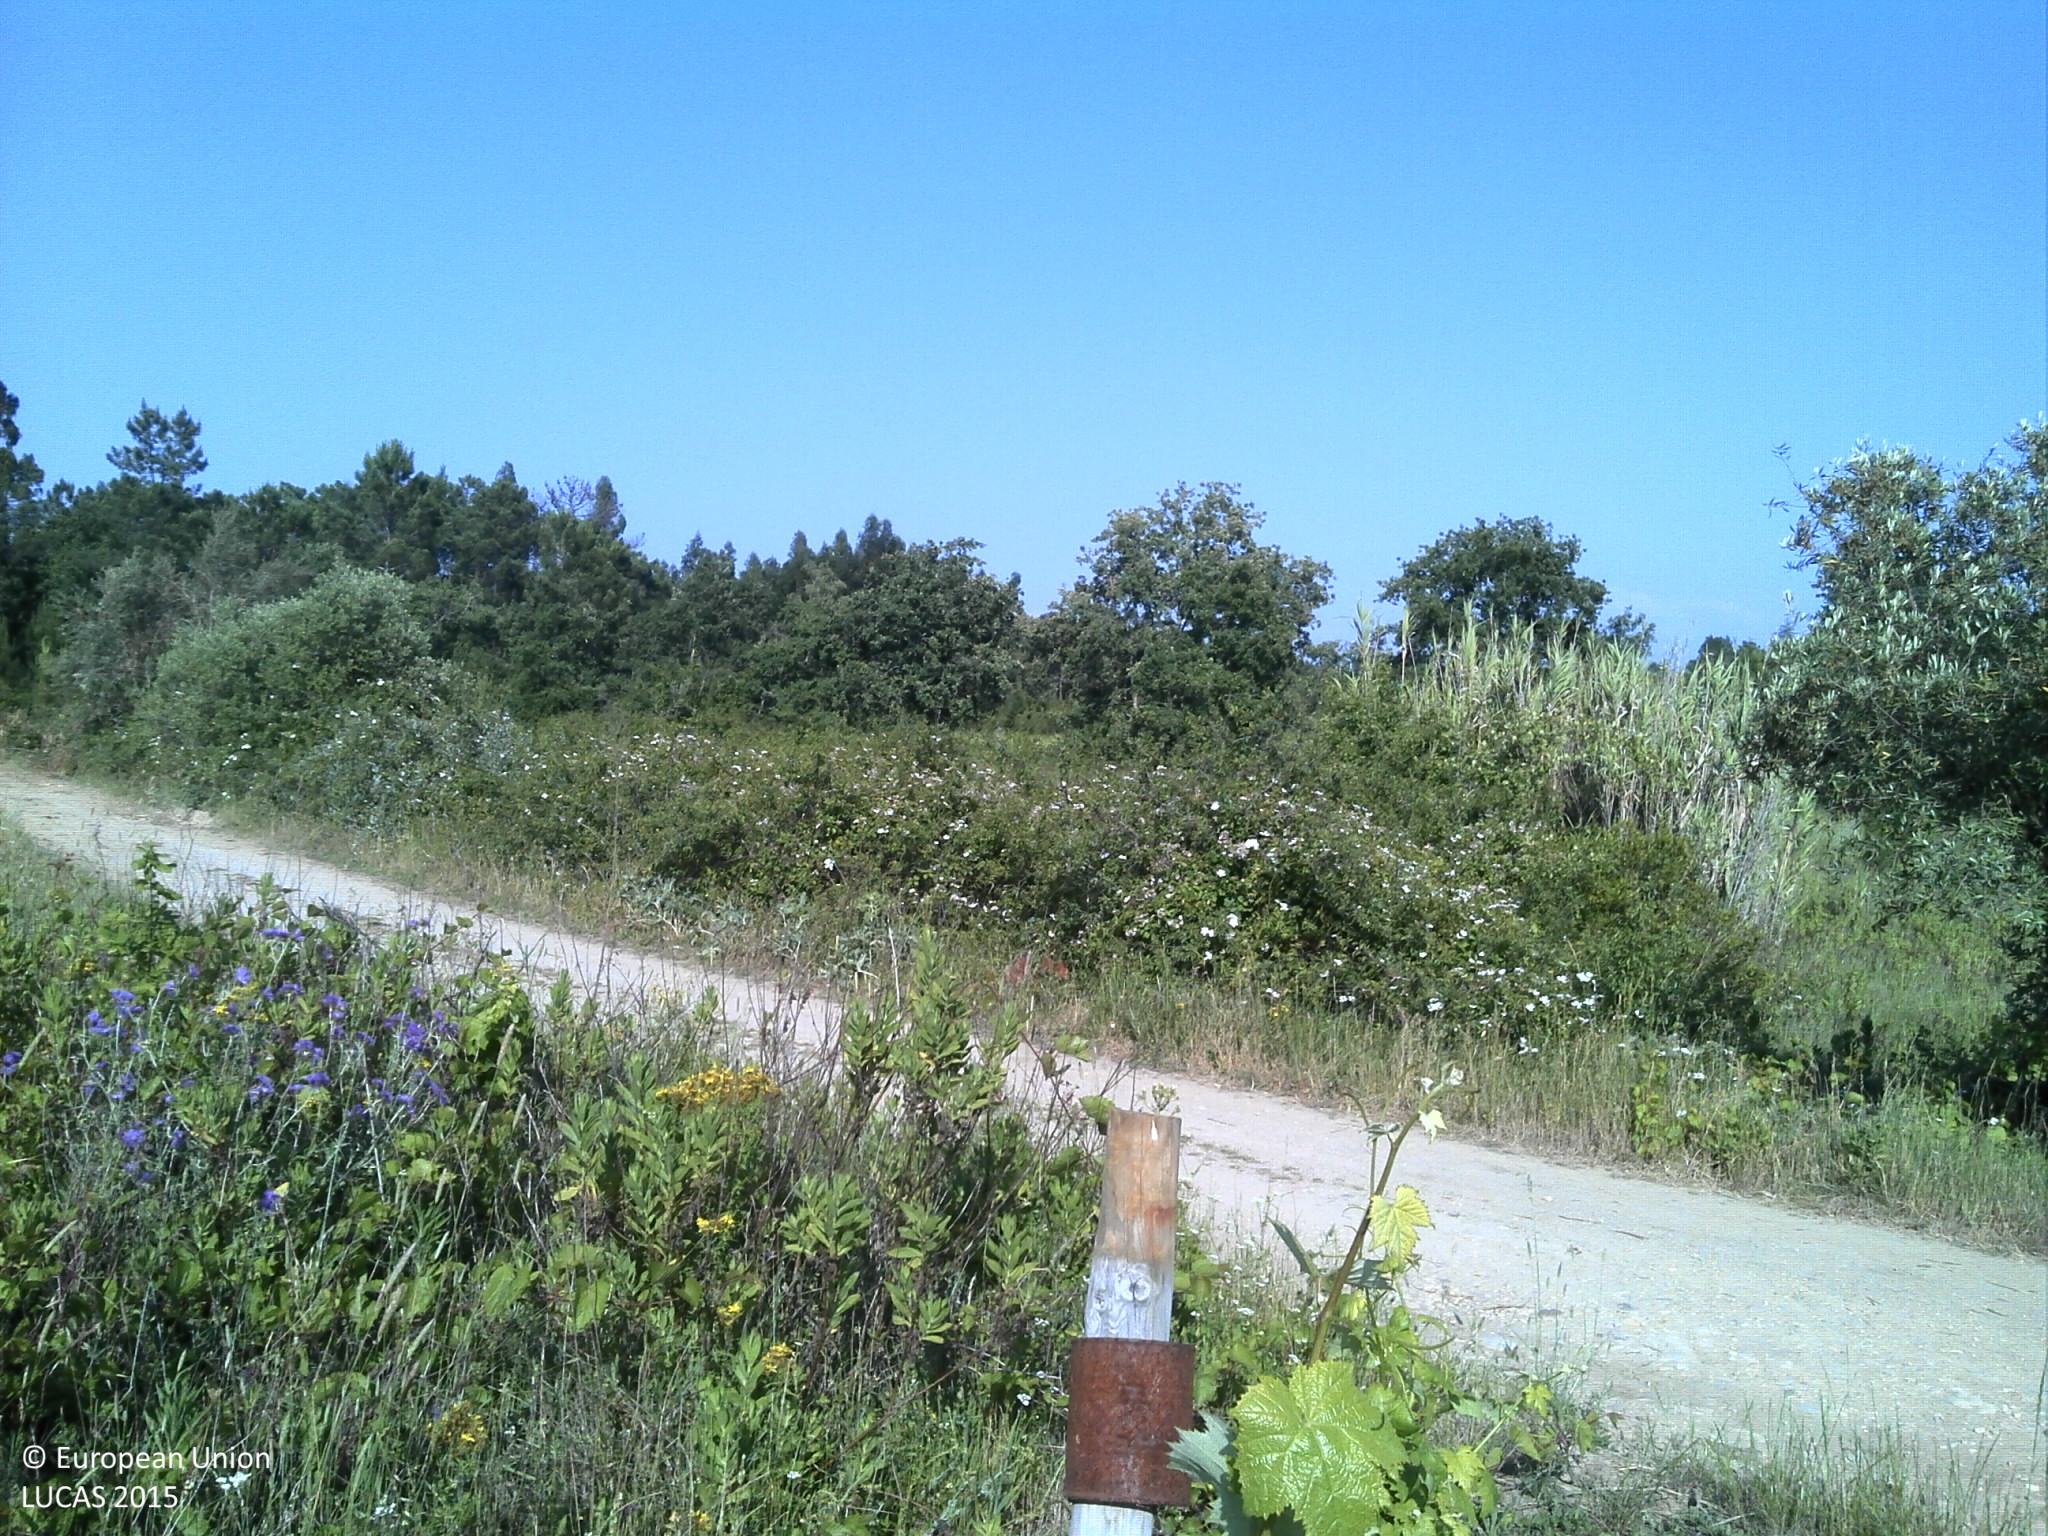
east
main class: Cropland
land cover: Vineyards
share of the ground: 25 - 50 %
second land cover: Spontaneously vegetated surfaces
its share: 25 - 50 %
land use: Agriculture (excluding fallow land and kitchen gardens)
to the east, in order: Vineyards; Spontaneously vegetated surfaces; Tracks; Shrubland without tree cover; Spontaneously vegetated surfaces; Abandoned hedges; Olive groves; Vineyards; Pine dominated coniferous woodland; Vineyards; Spontaneously vegetated surfaces; Vineyards
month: June
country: PT
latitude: 40.2989
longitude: -8.6201
